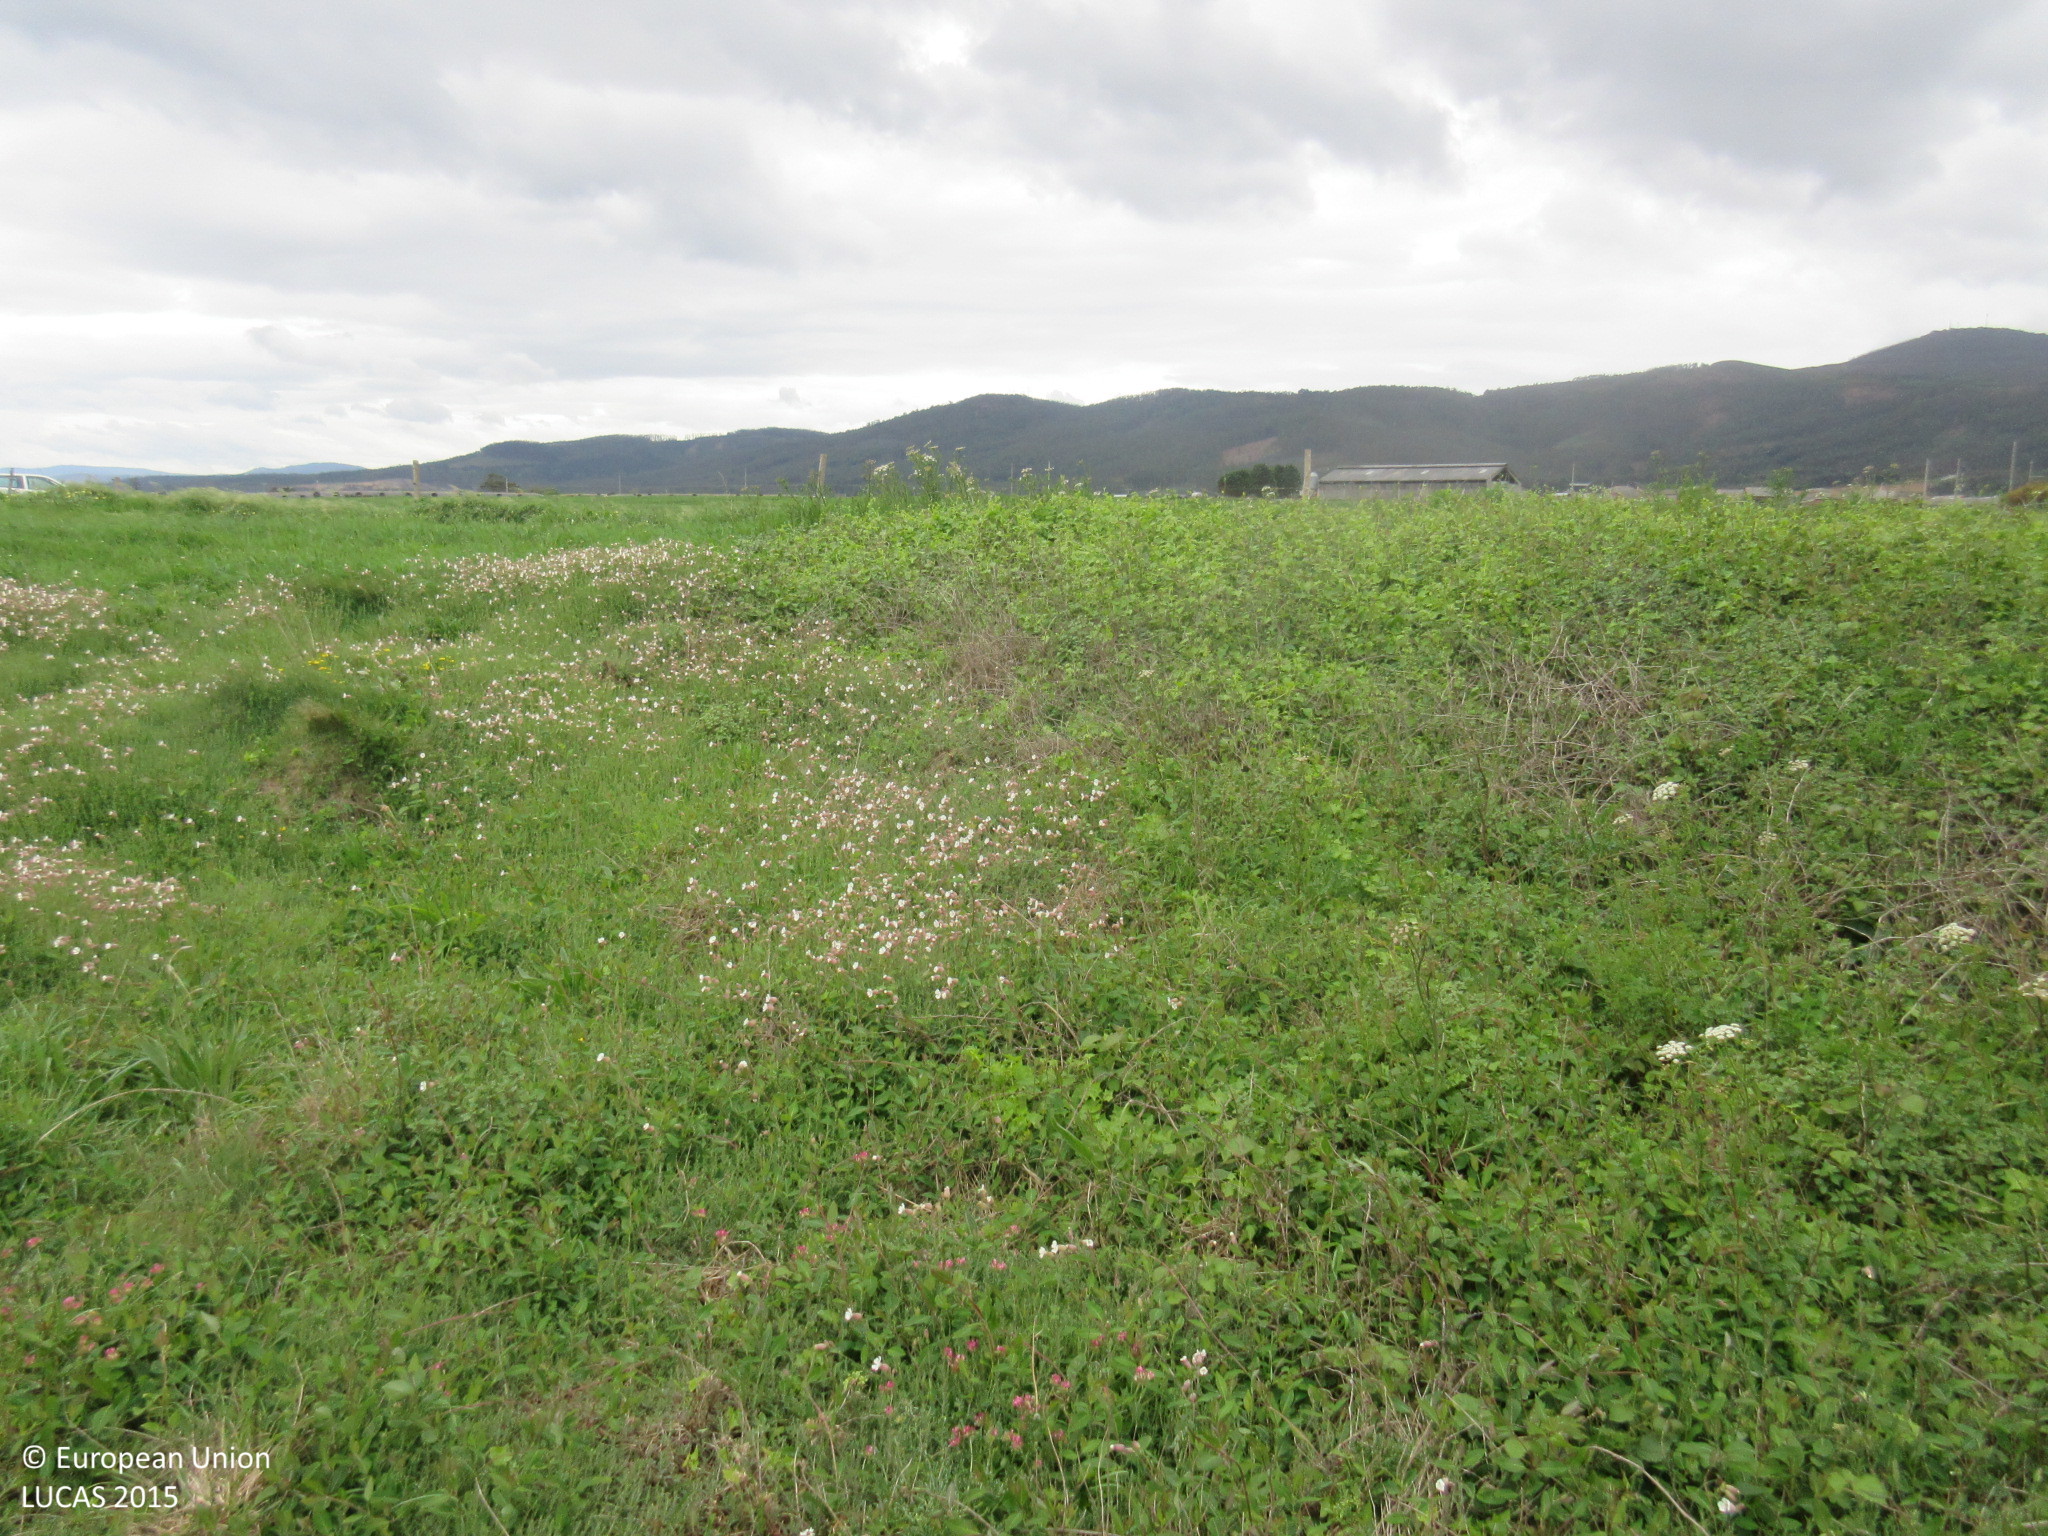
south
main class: Shrubland
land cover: Shrubland without tree cover
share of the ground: > 75 %
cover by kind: herbaceous plants 80 %, shrubs 20 %
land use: Semi-natural and natural areas not in use
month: April
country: ES
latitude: 43.5553
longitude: -7.1427
